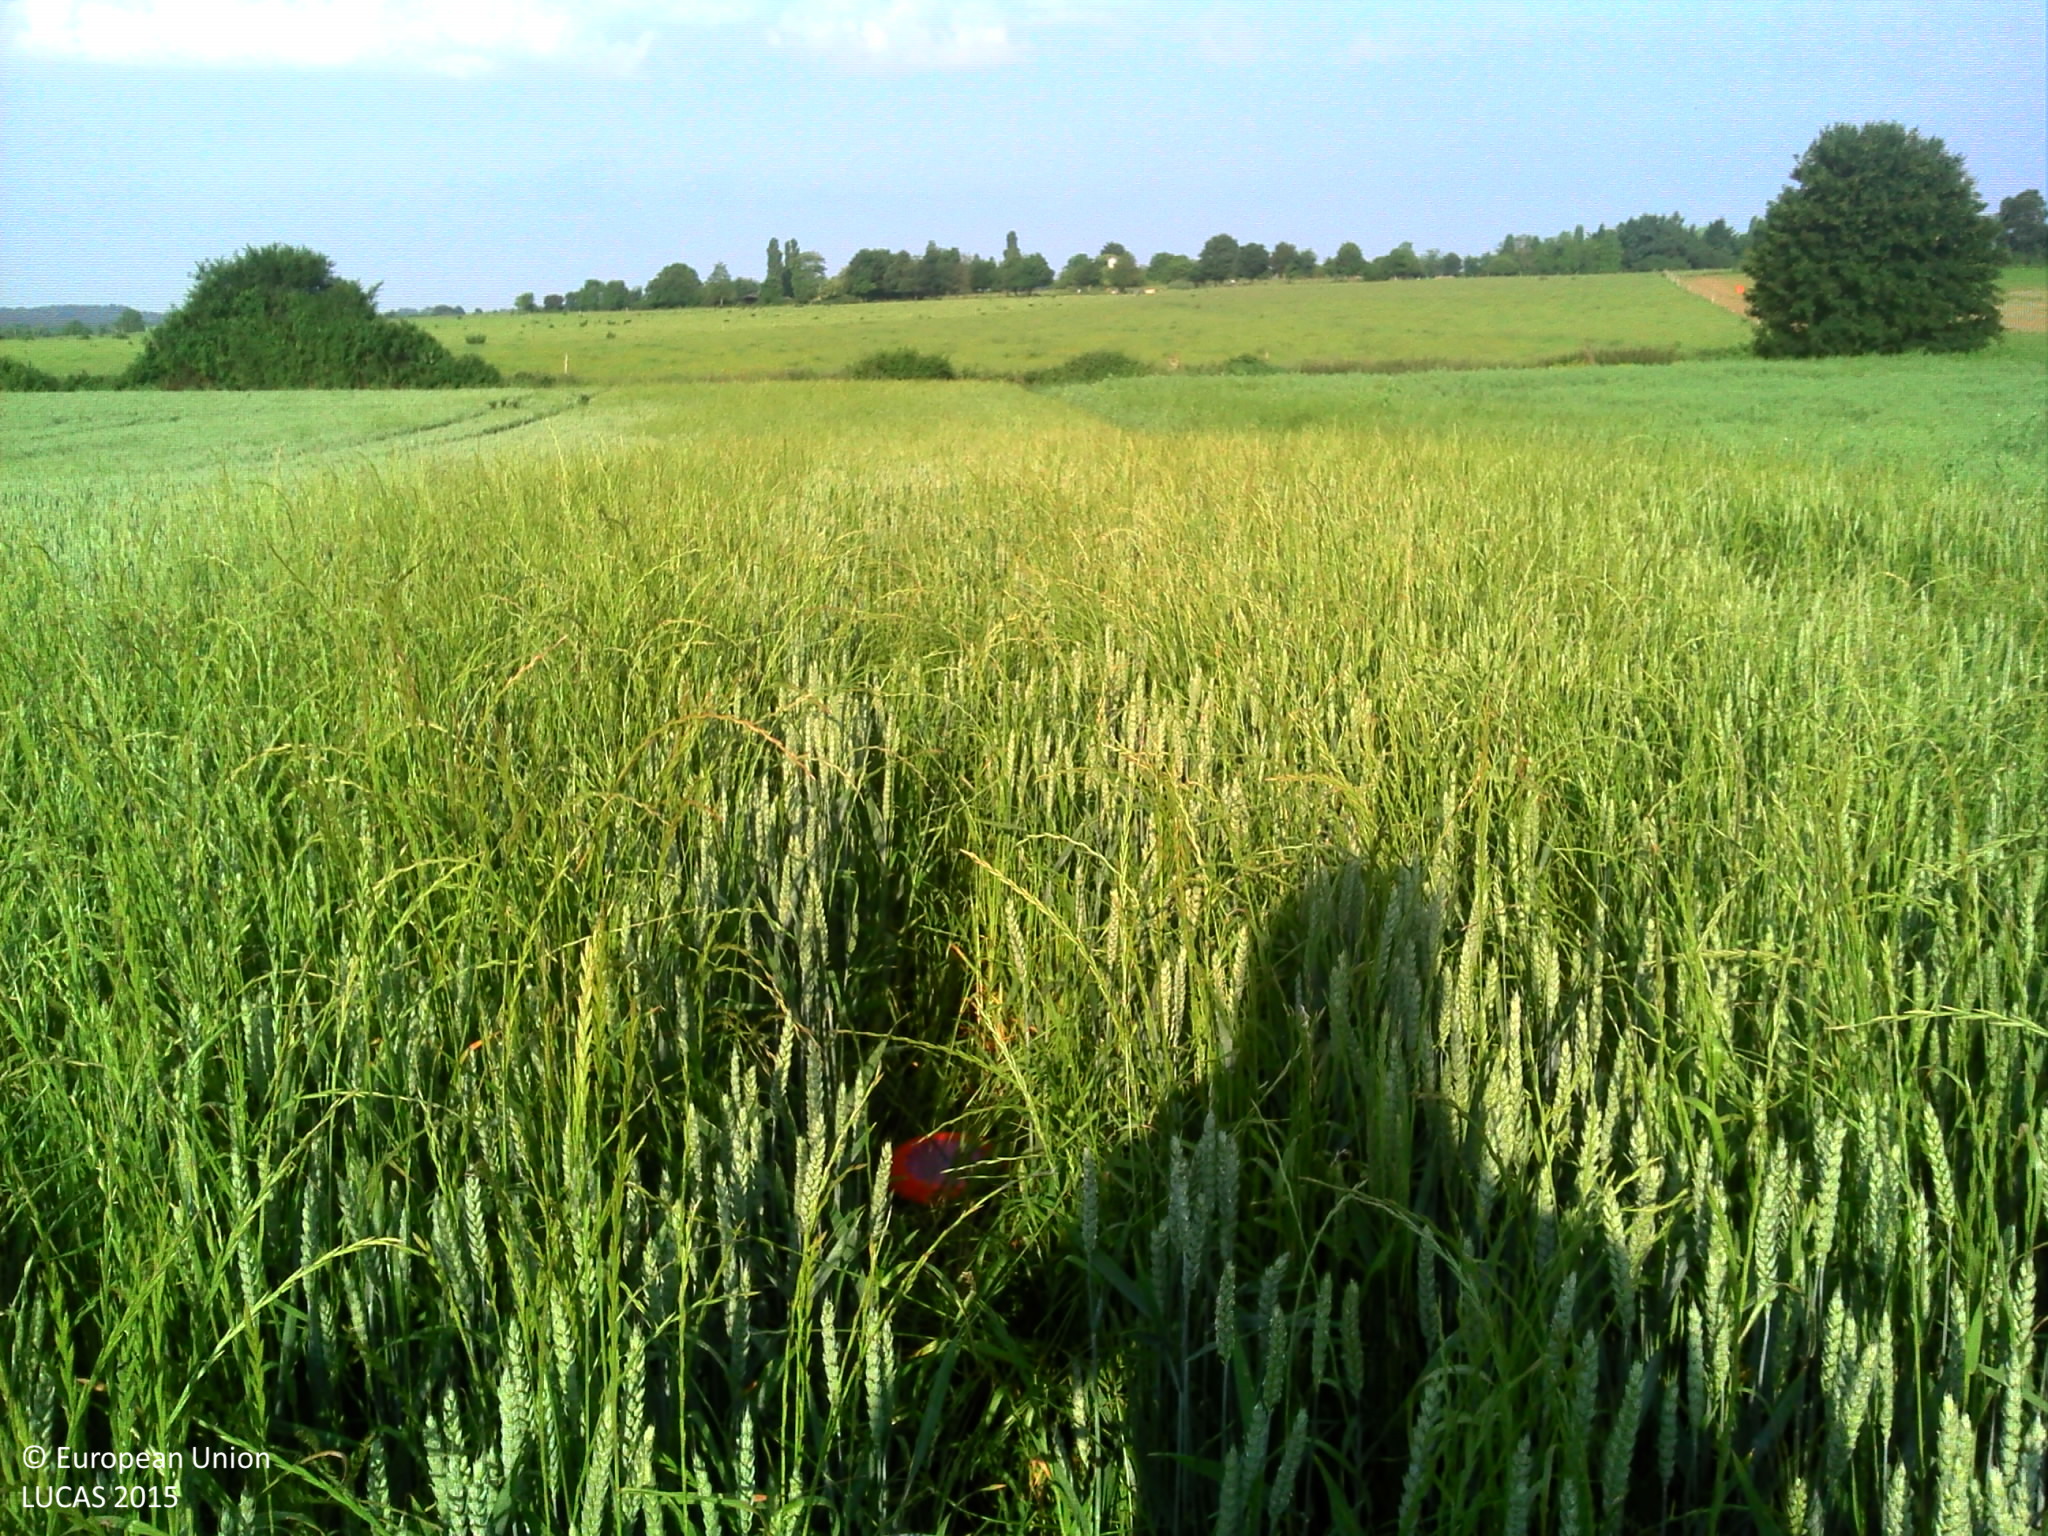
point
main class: Cropland
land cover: Mixed cereals for fodder
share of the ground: > 75 %
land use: Agriculture (excluding fallow land and kitchen gardens)
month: June
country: FR
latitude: 47.9464
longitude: -0.0294
